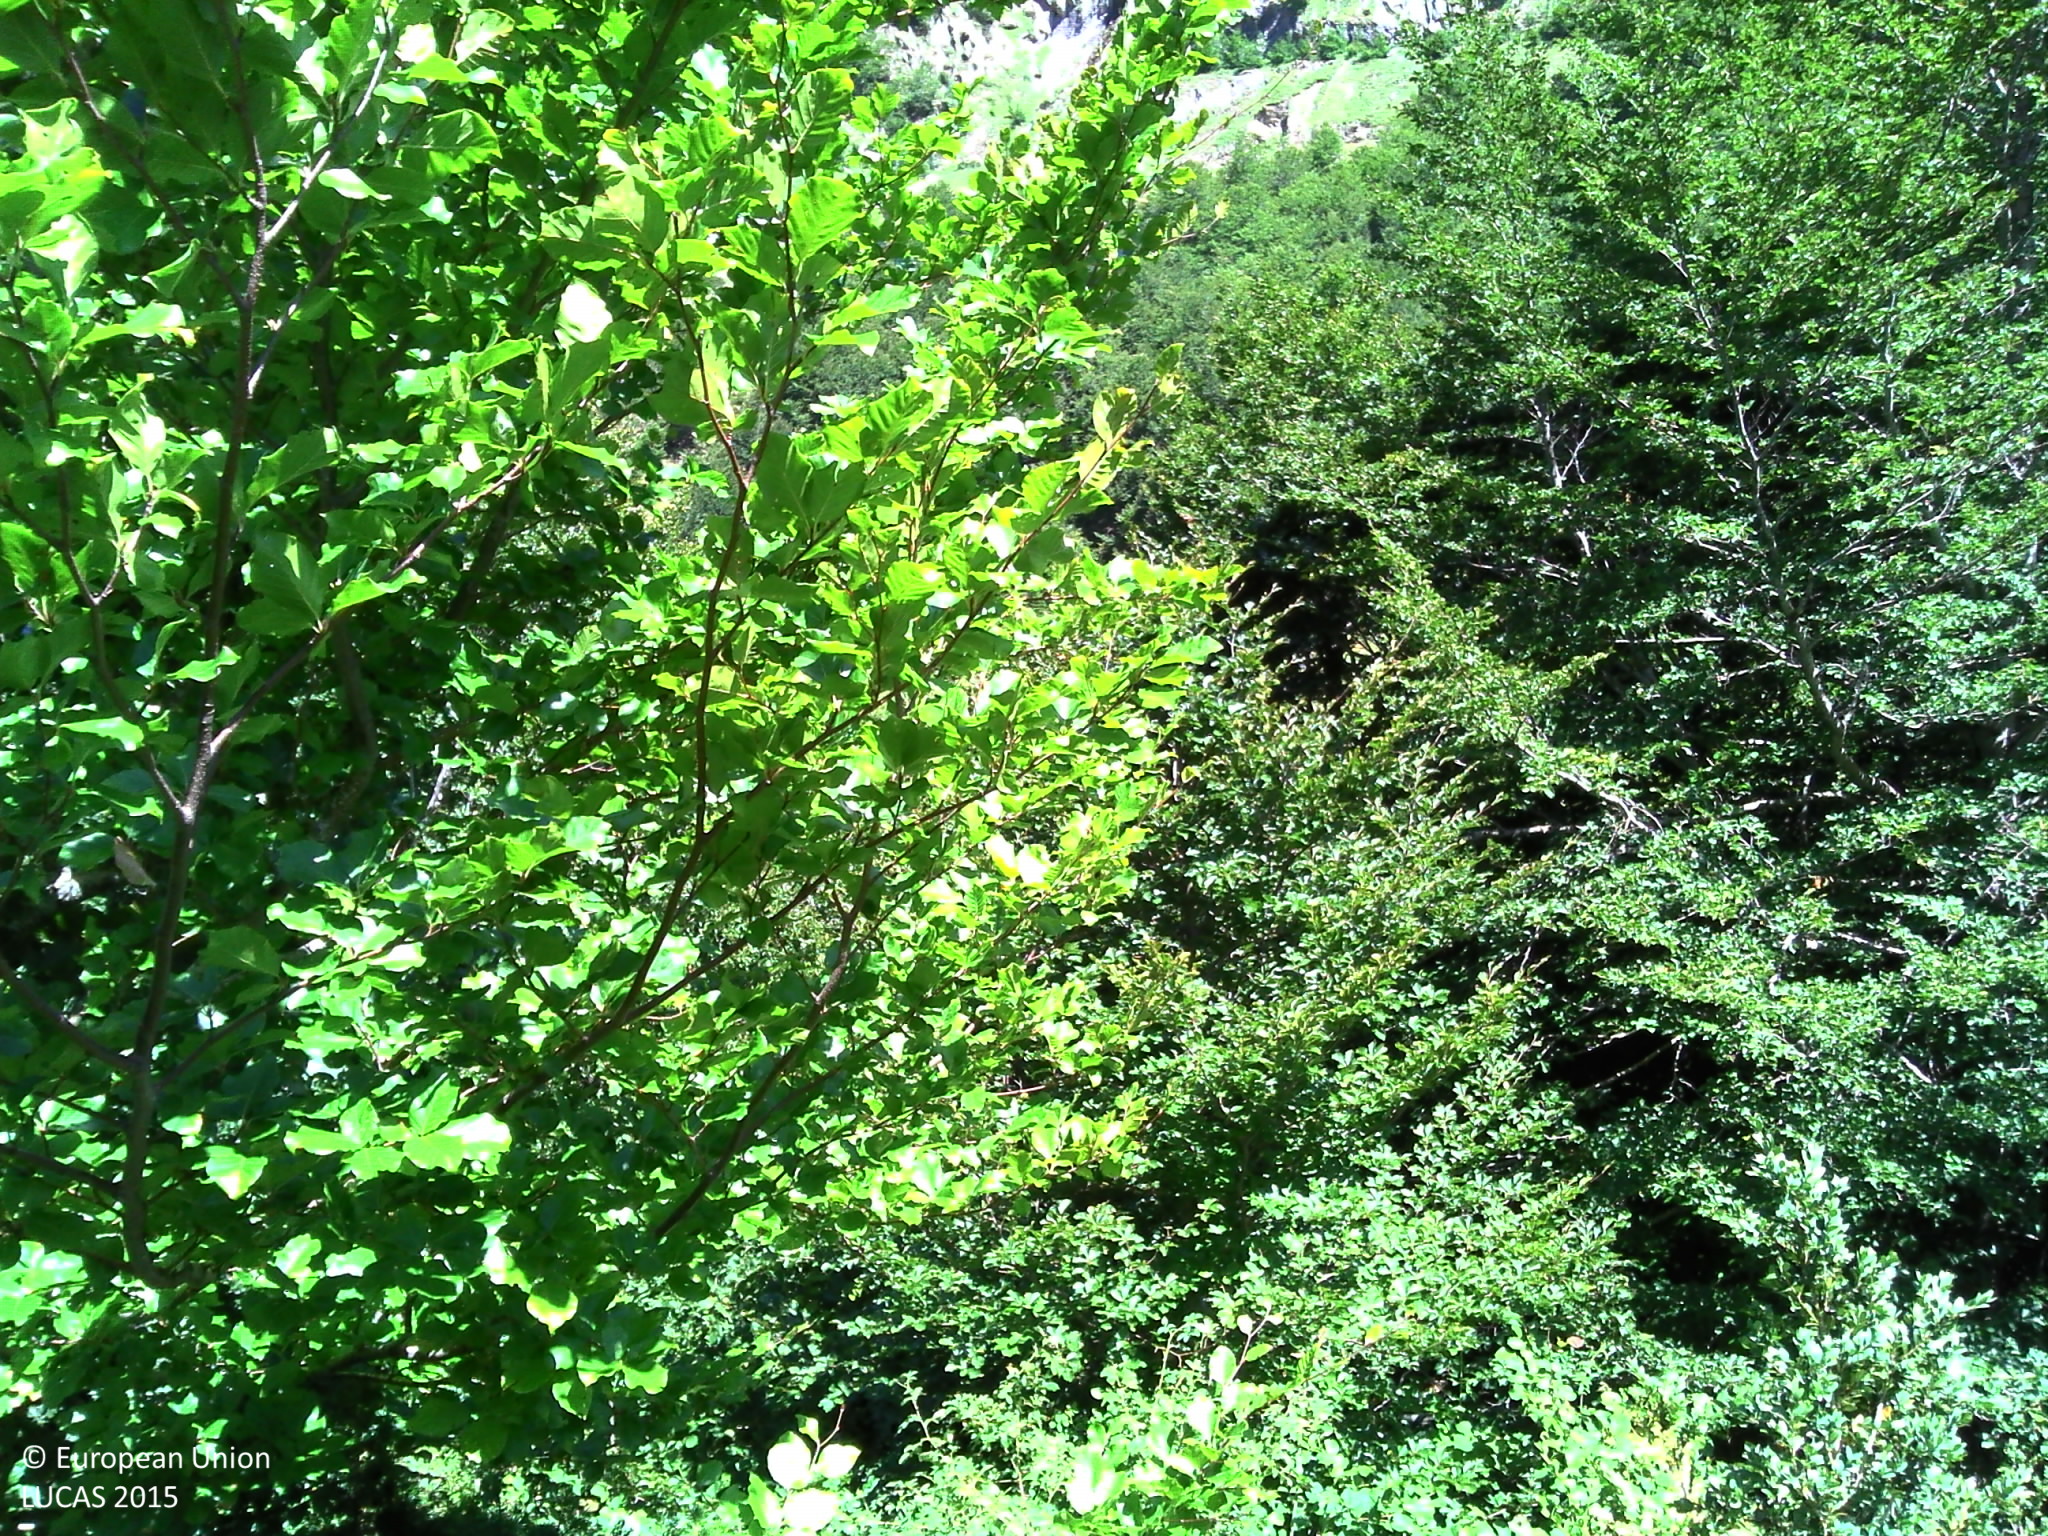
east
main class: Woodland
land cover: Broadleaved woodland
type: beech forest
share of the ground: 25 - 50 %
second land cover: Grassland without tree/shrub cover
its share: 50 - 75 %
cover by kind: herbaceous plants 40 %, broadleaved forest trees 35 %, shrubs 15 %, lichens and mosses 5 %, consolidated bare surface 5 %
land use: Forestry
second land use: Agriculture (excluding fallow land and kitchen gardens)
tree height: > 5 m
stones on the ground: 10 - 25 %
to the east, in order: Broadleaved woodland; Grassland without tree/shrub cover; Rock outcrops; Inland fresh running water; Rock outcrops; Broadleaved woodland; Grassland with sparse tree/shrub cover; Tracks; Grassland with sparse tree/shrub cover; Broadleaved woodland; Shrubland with sparse tree cover
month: July
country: FR
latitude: 42.8278
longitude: -0.3890
